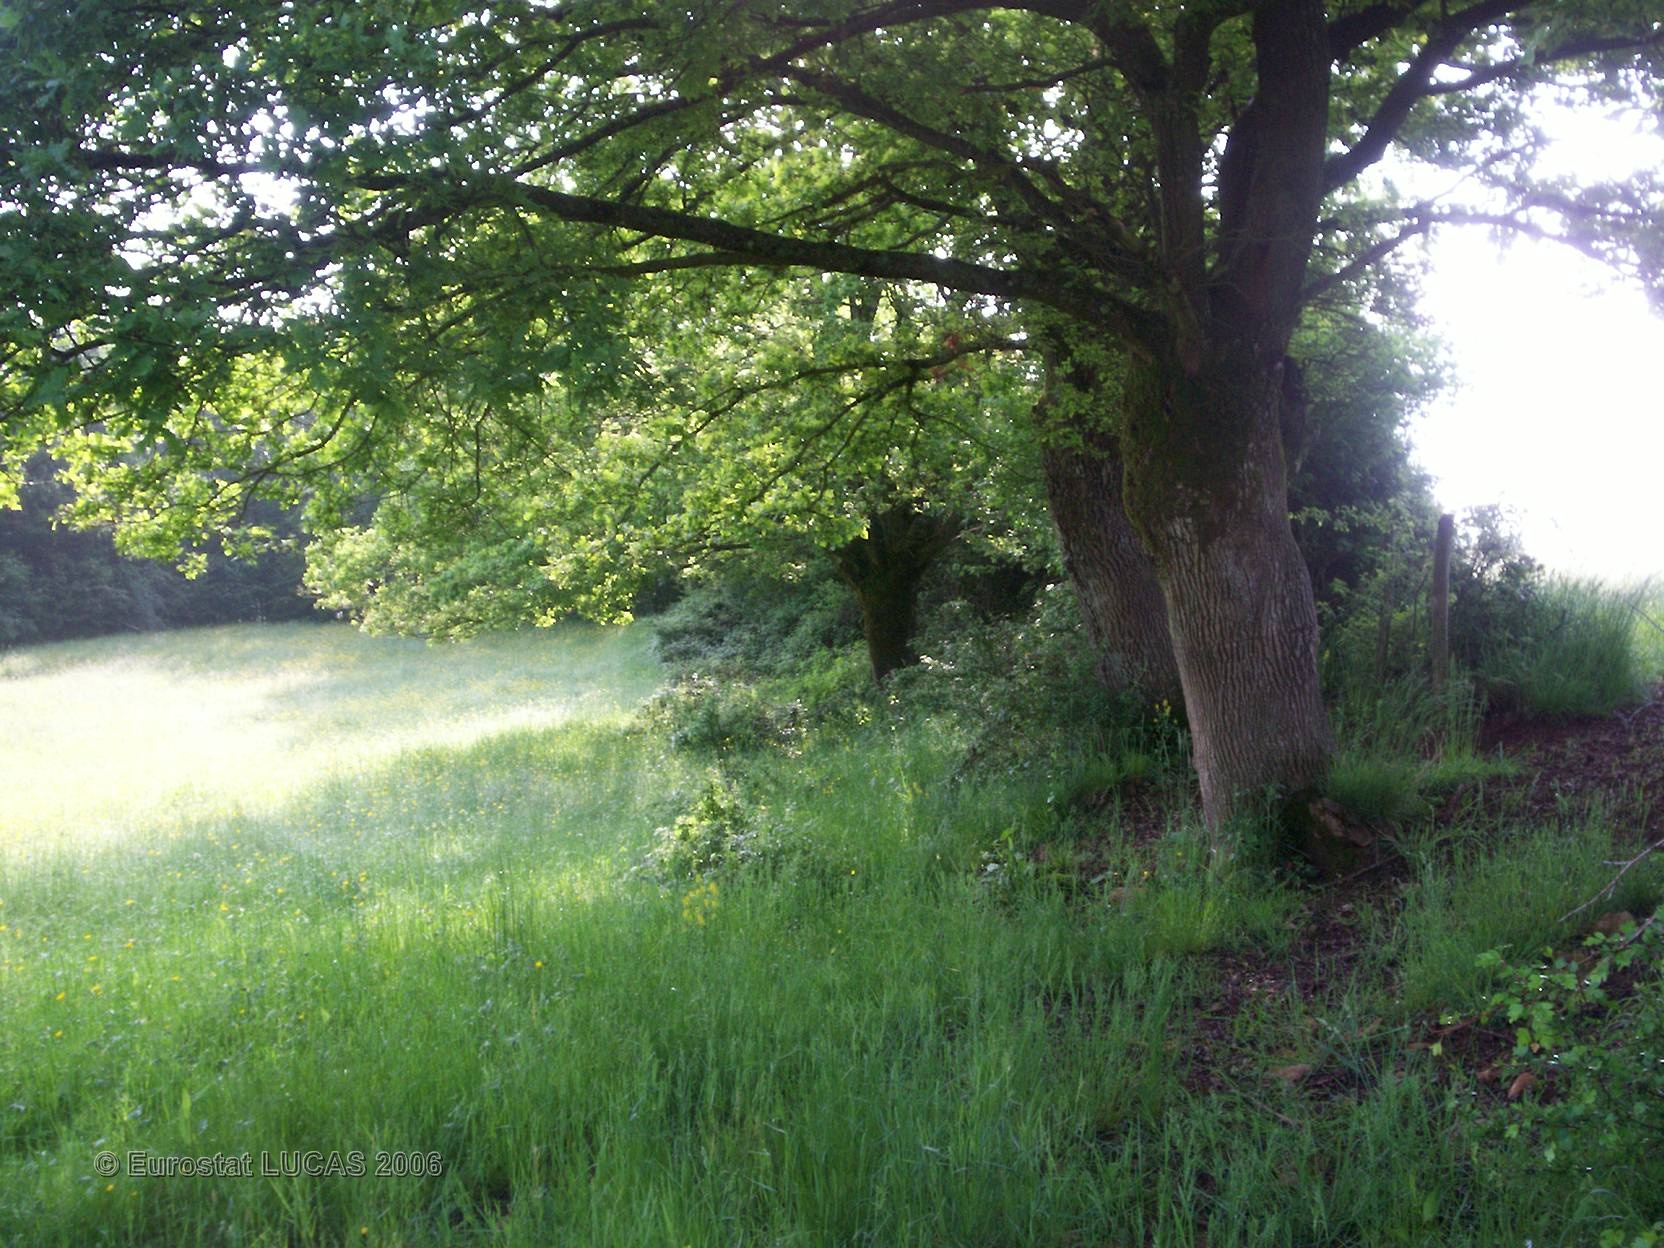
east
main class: Grassland
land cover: Grassland without tree/shrub cover
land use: Agriculture (excluding fallow land and kitchen gardens)
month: May
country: FR
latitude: 46.7214
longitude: 4.6238
